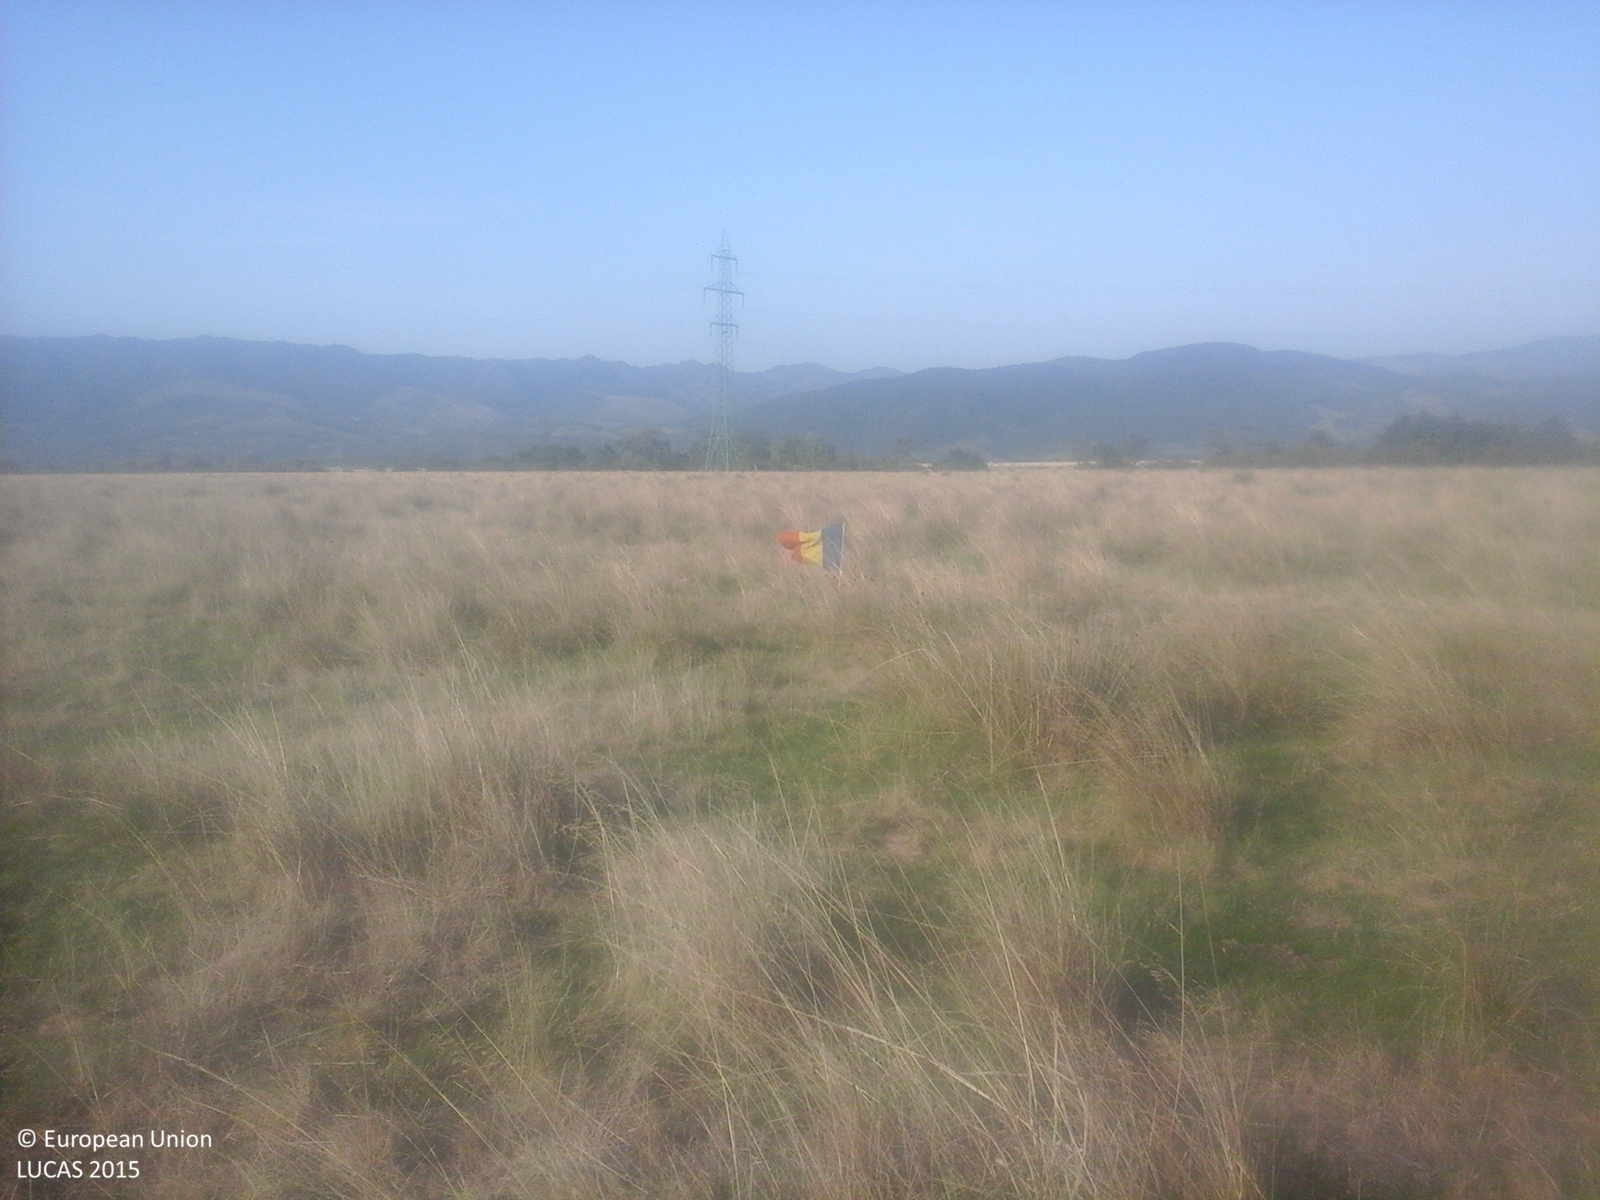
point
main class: Grassland
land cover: Grassland without tree/shrub cover
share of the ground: > 75 %
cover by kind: herbaceous plants 100 %
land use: Agriculture (excluding fallow land and kitchen gardens)
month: September
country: RO
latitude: 45.4909
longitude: 23.0669
